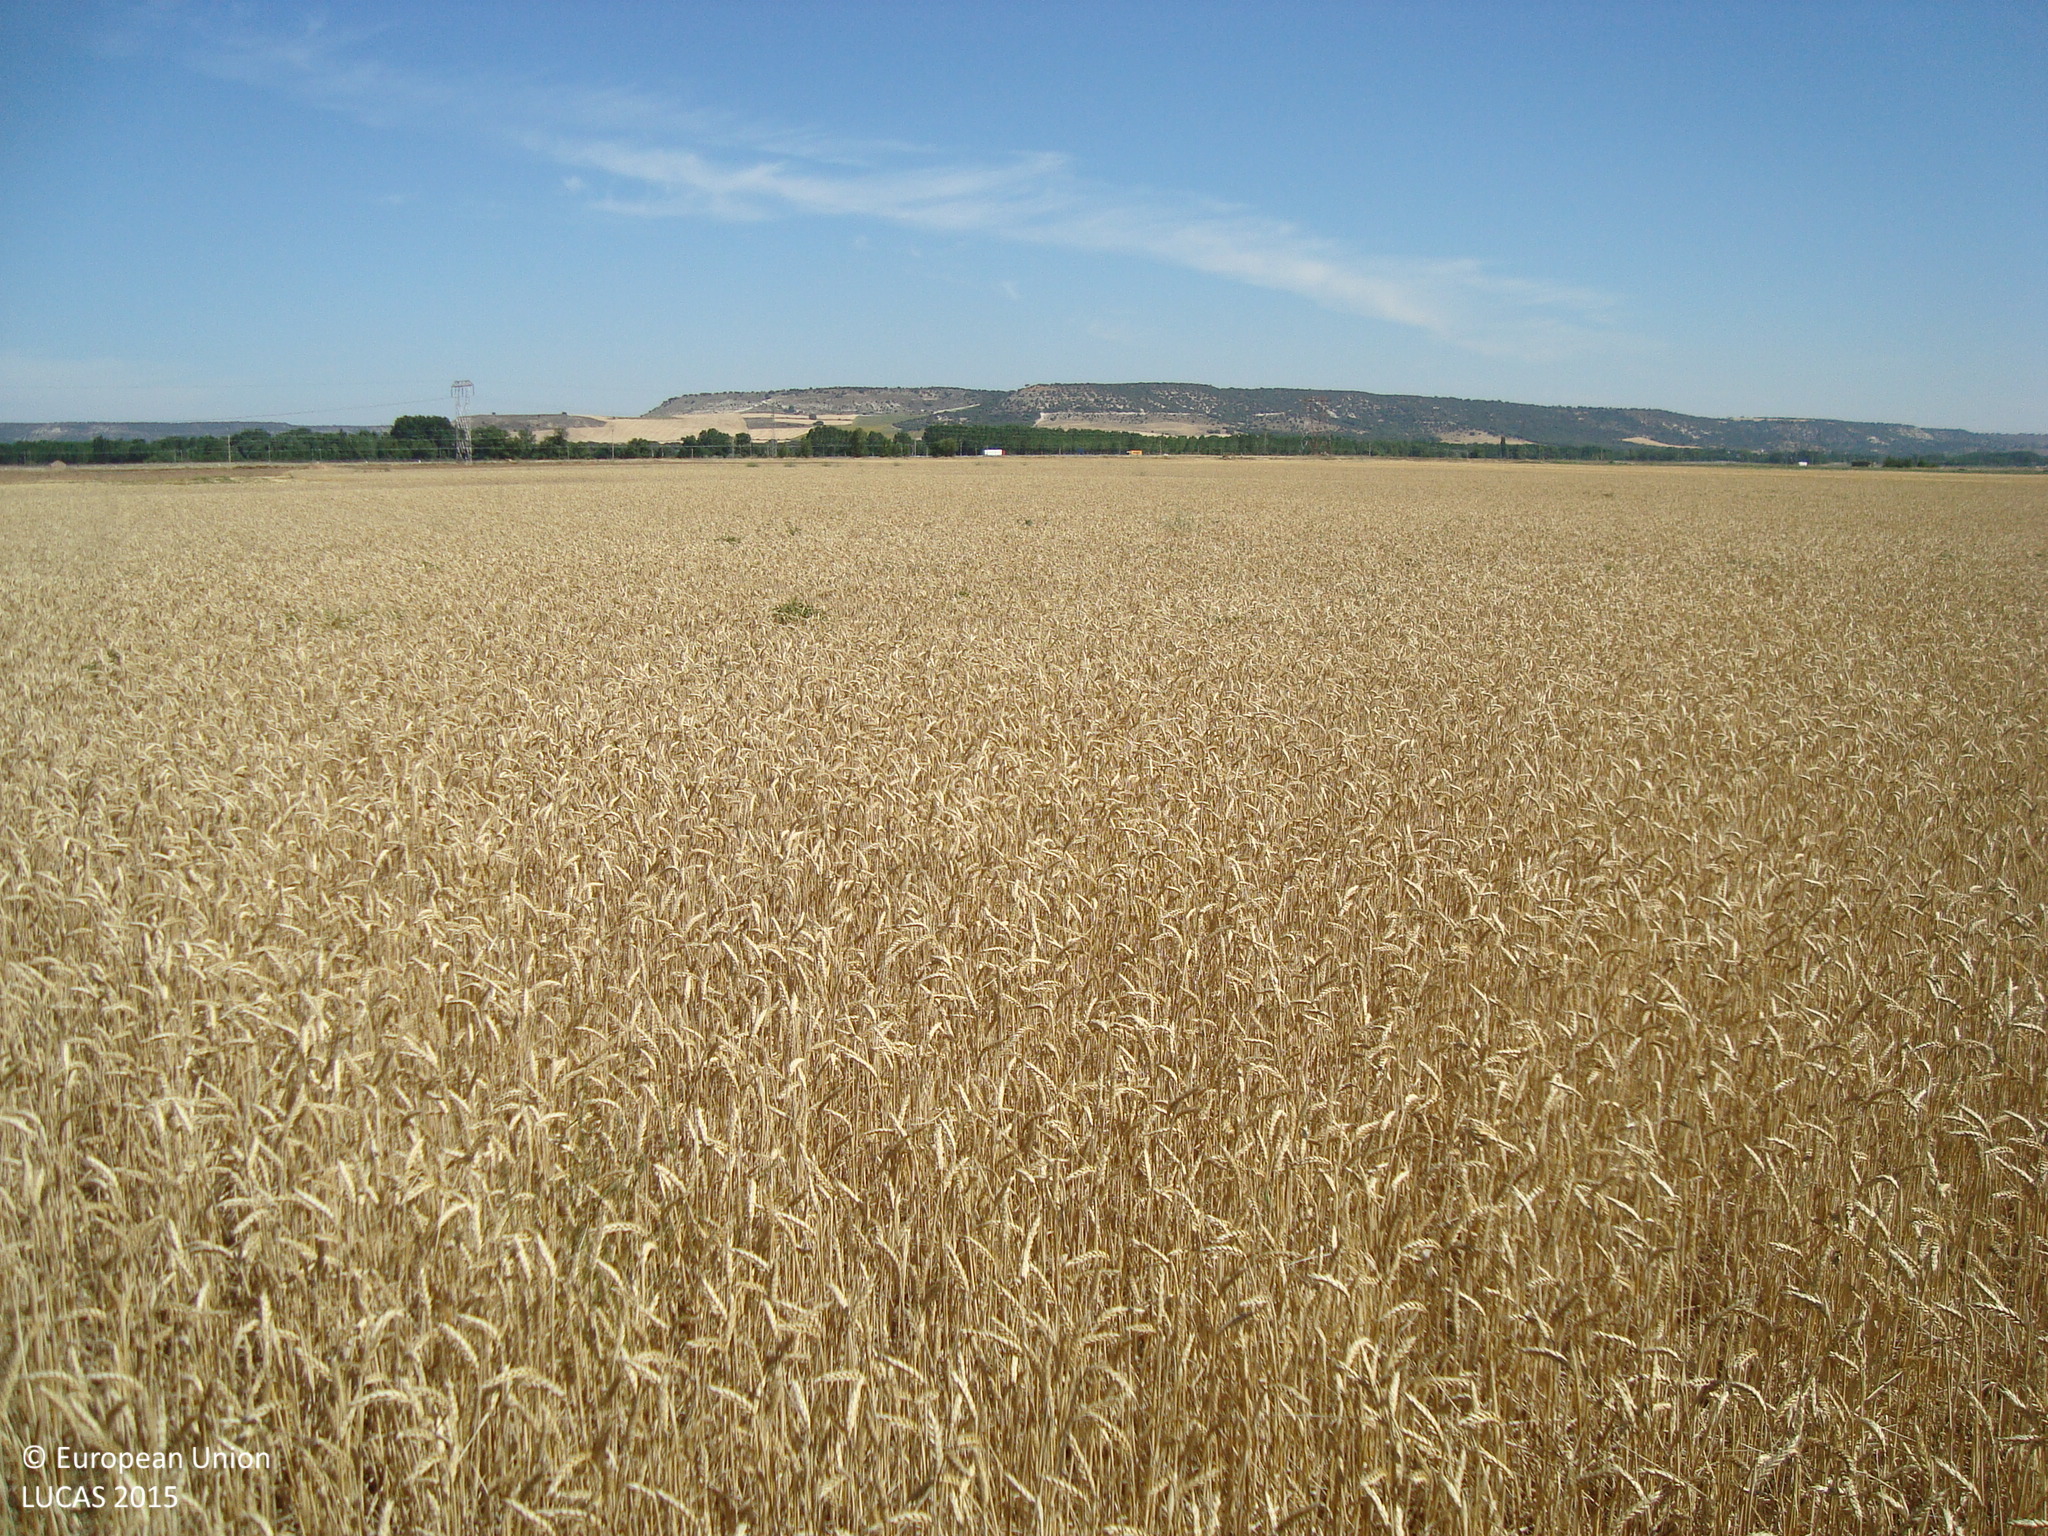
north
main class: Cropland
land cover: Common wheat
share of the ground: > 75 %
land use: Agriculture (excluding fallow land and kitchen gardens)
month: July
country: ES
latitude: 42.0453
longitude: -4.2371
